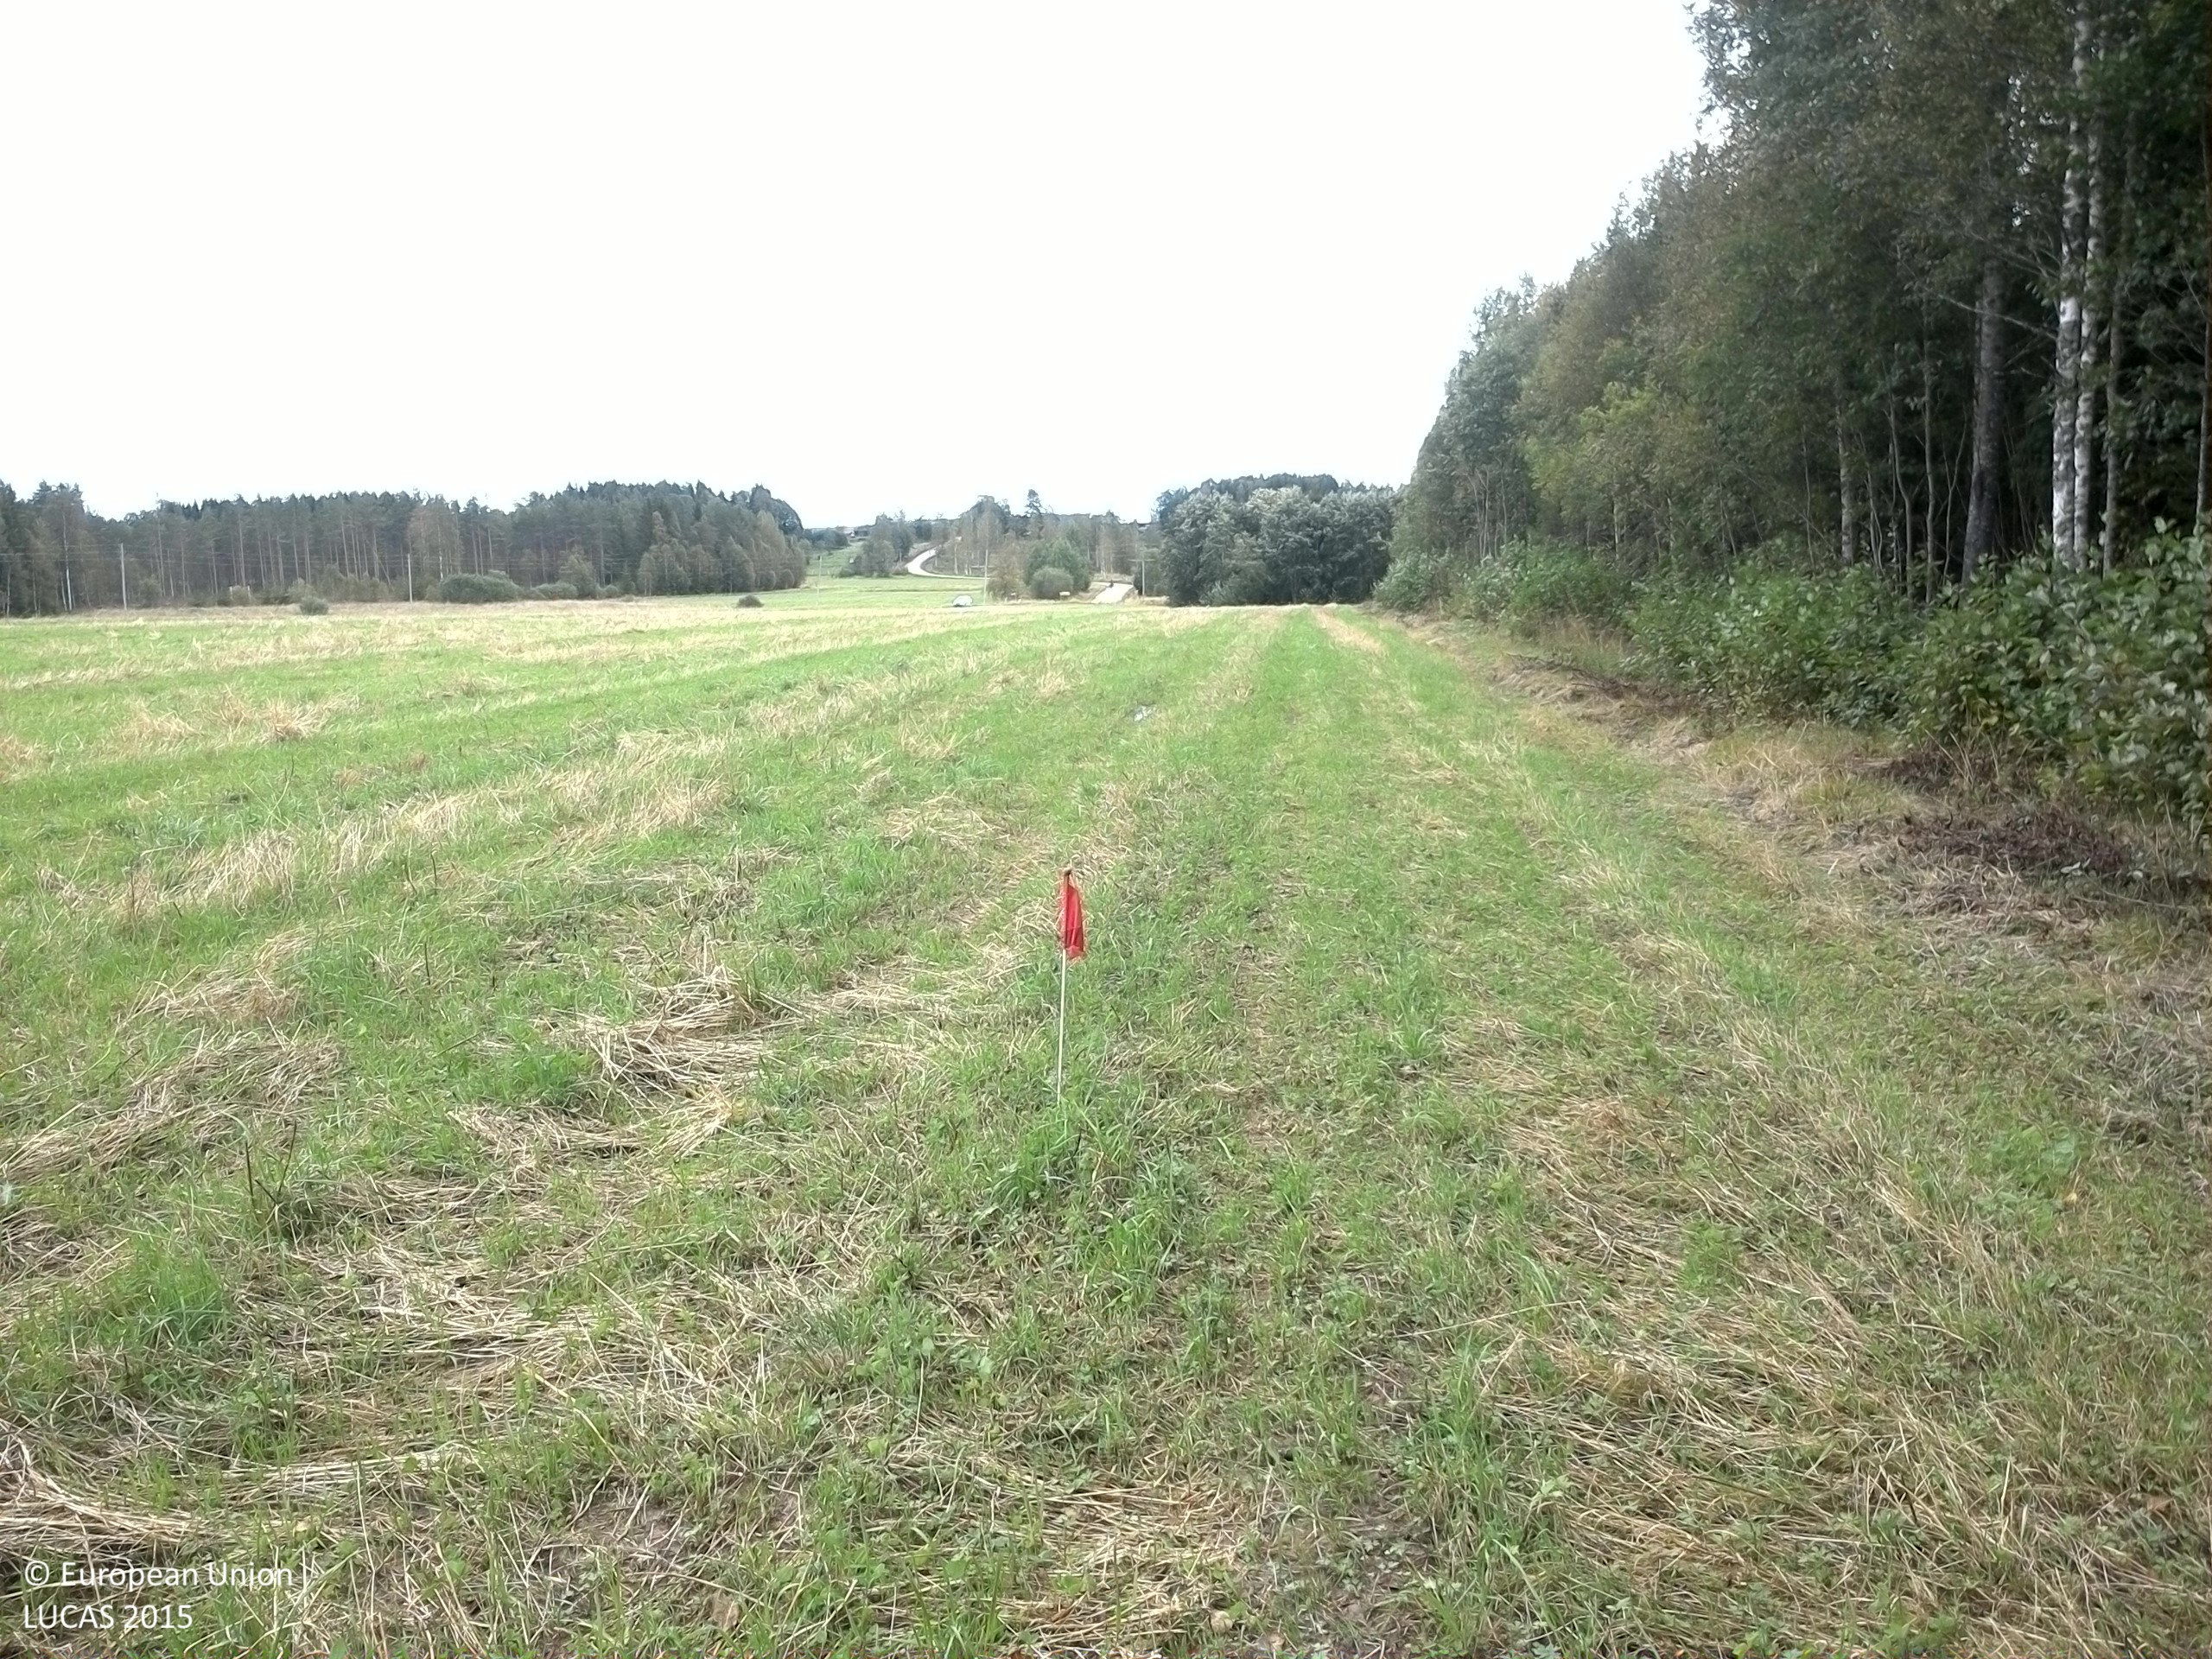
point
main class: Grassland
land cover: Grassland without tree/shrub cover
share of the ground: > 75 %
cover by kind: herbaceous plants 90 %, consolidated bare surface 10 %
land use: Agriculture (excluding fallow land and kitchen gardens)
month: September
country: SE
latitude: 59.8317
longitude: 13.4700
